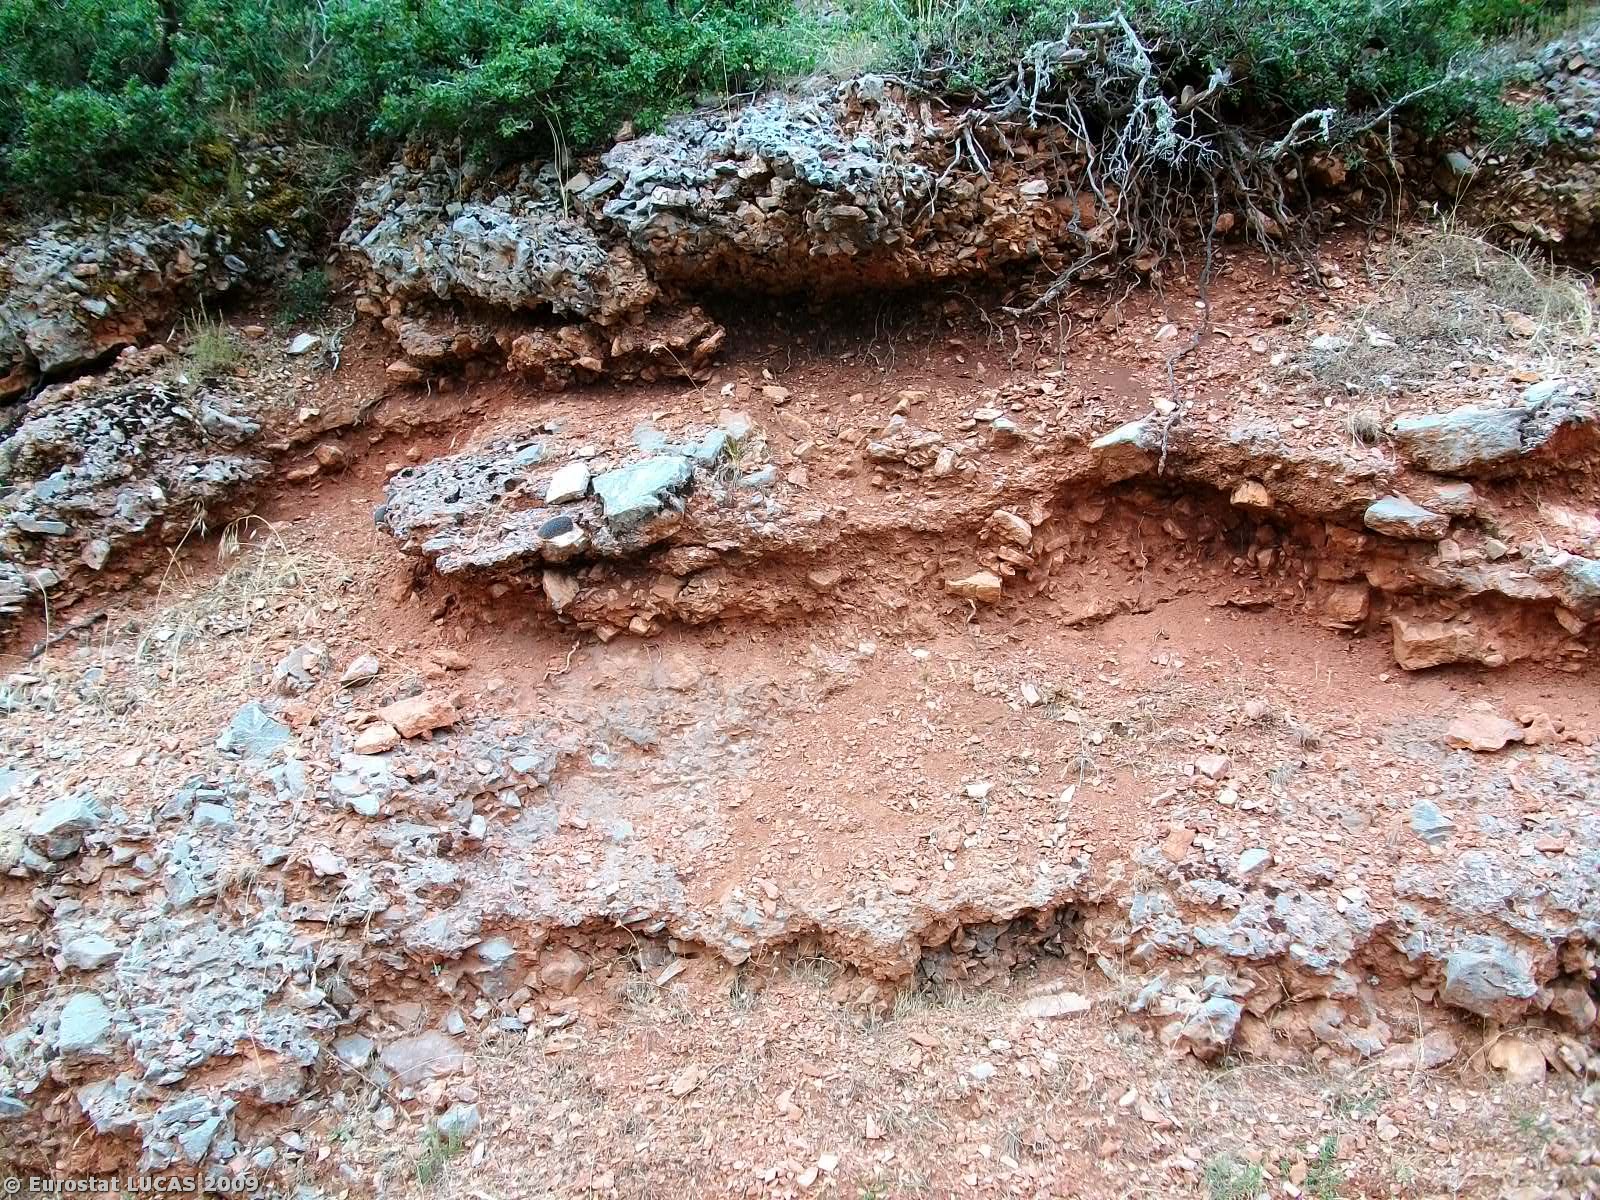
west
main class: Woodland
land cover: Broadleaved woodland
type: broadleaved evergreen forest
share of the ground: > 75 %
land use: Forestry
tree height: > 5 m
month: August
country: GR
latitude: 38.7235
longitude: 21.5546
